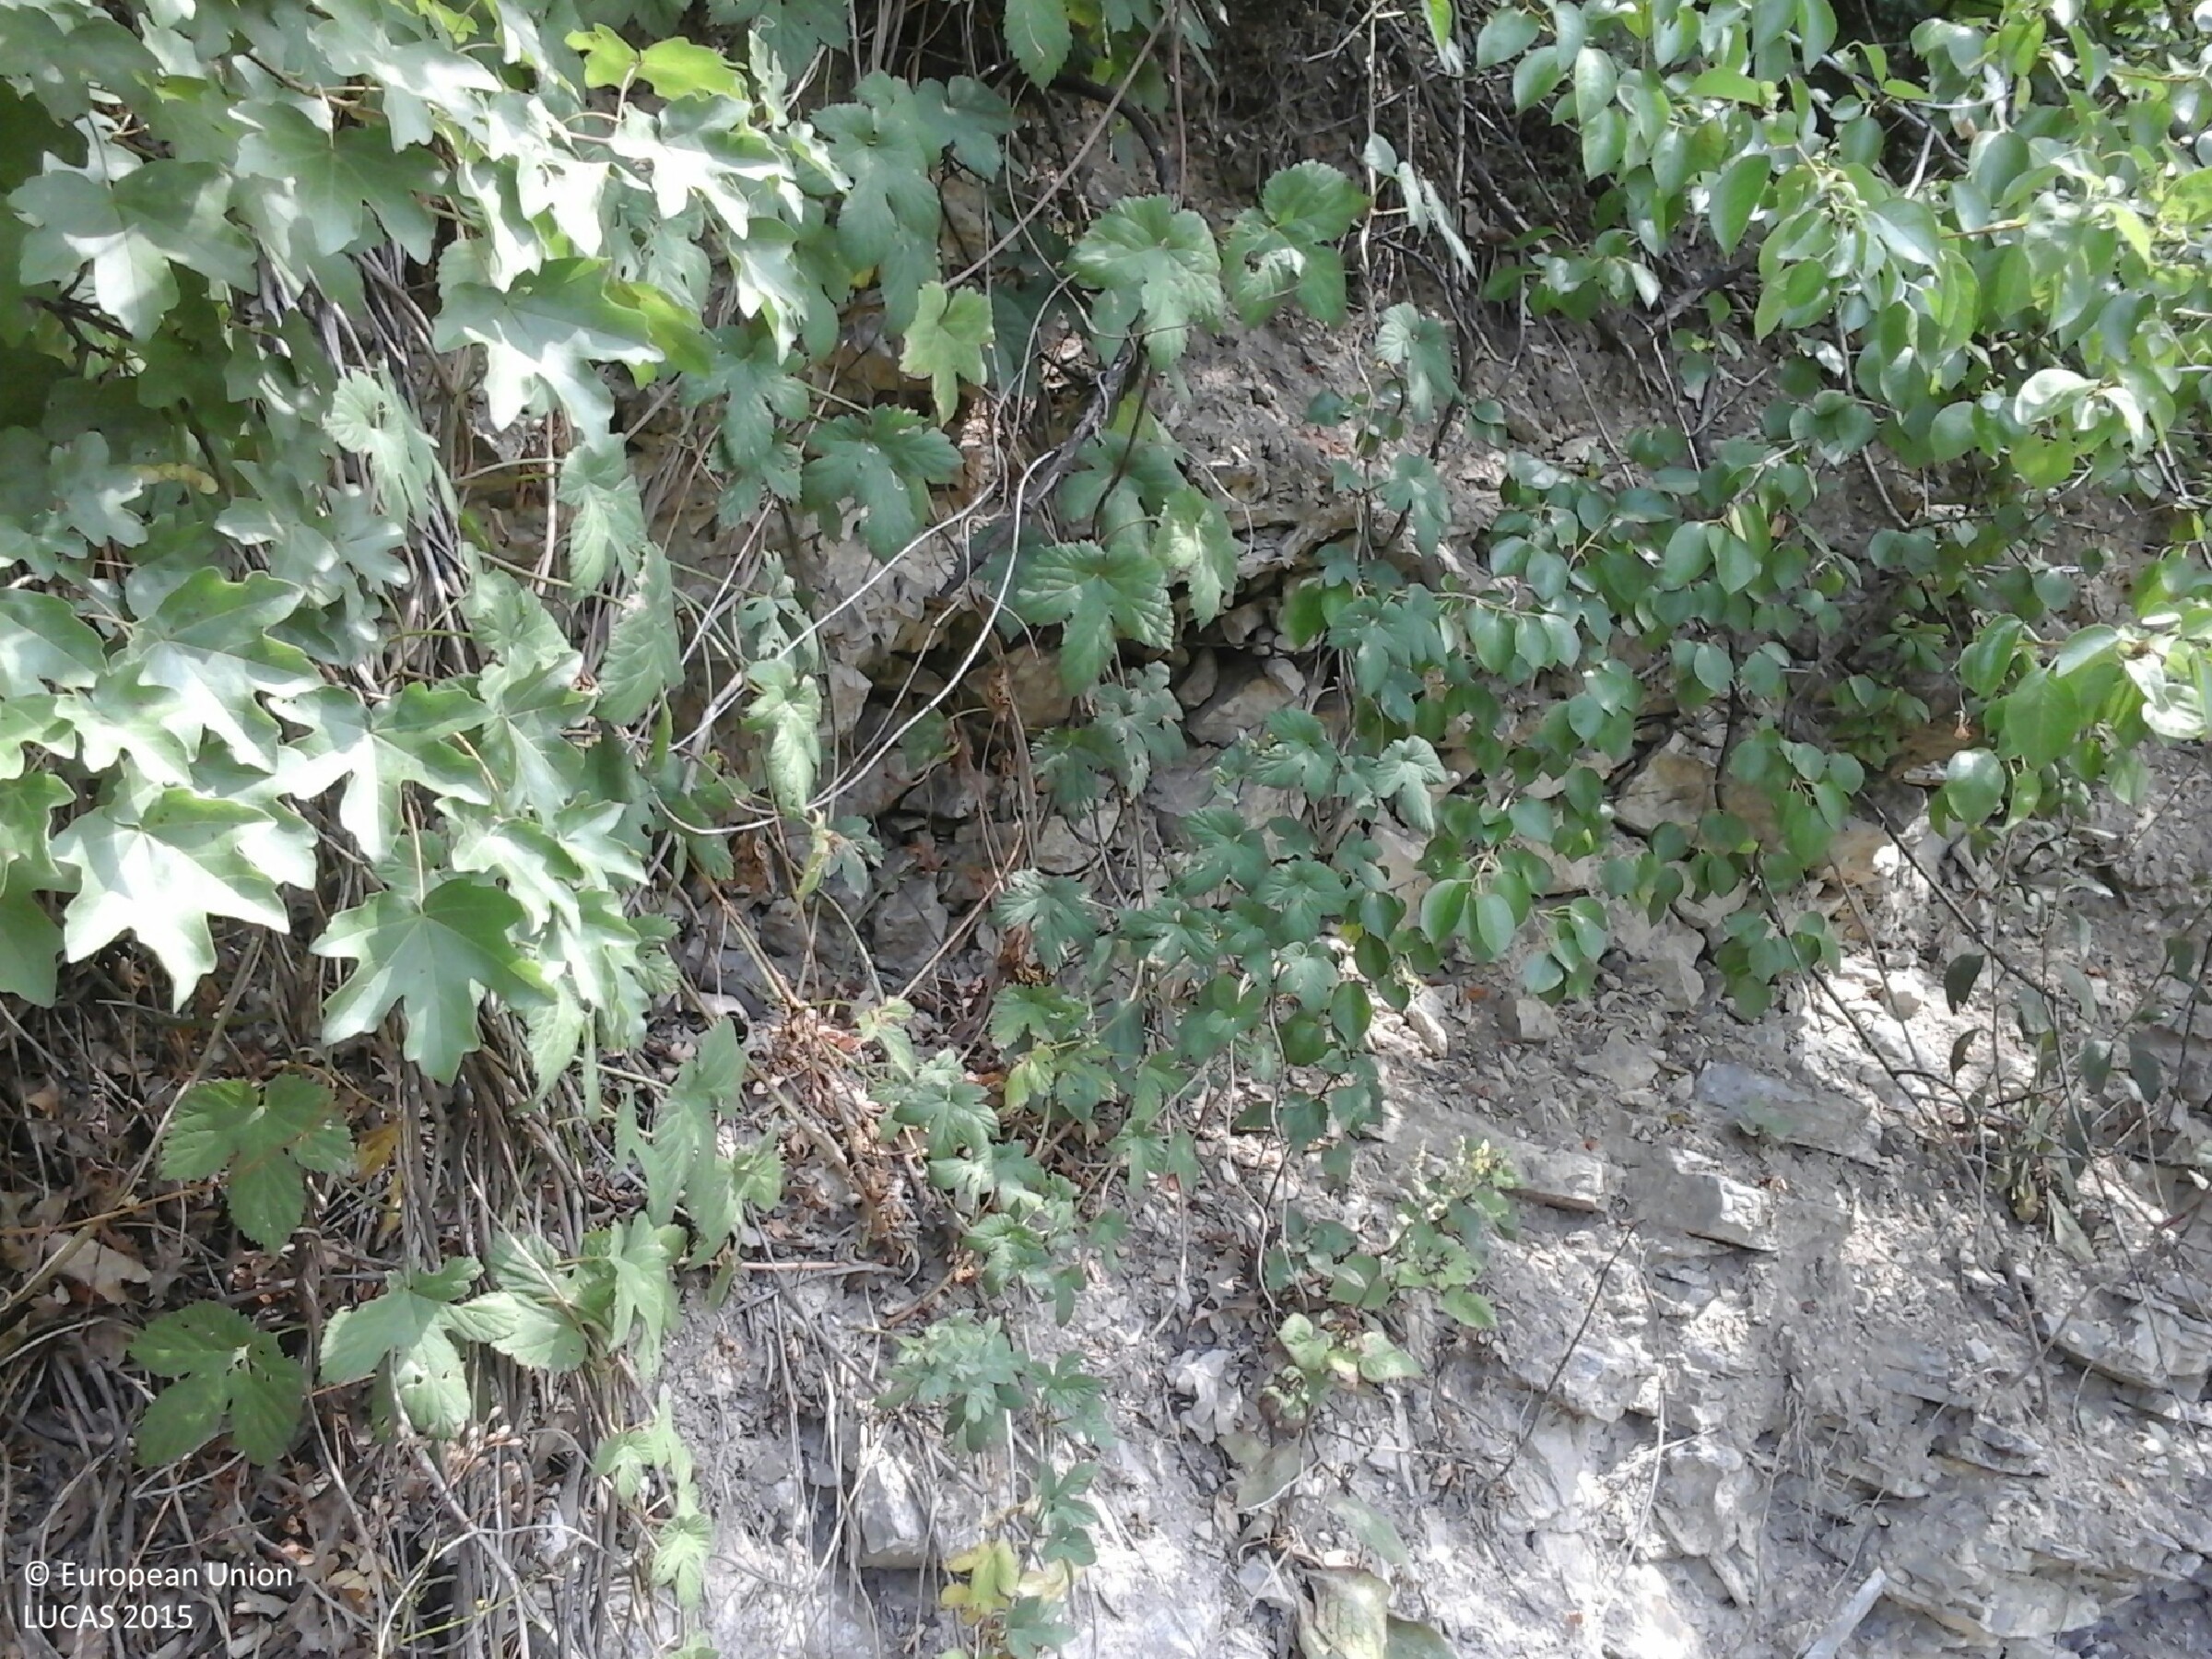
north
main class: Woodland
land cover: Broadleaved woodland
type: mesophytic deciduous forest
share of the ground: > 75 %
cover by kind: broadleaved forest trees 75 %, shrubs 20 %, herbaceous plants 5 %
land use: Forestry
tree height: > 5 m
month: July
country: HU
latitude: 48.1072
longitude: 20.6315
